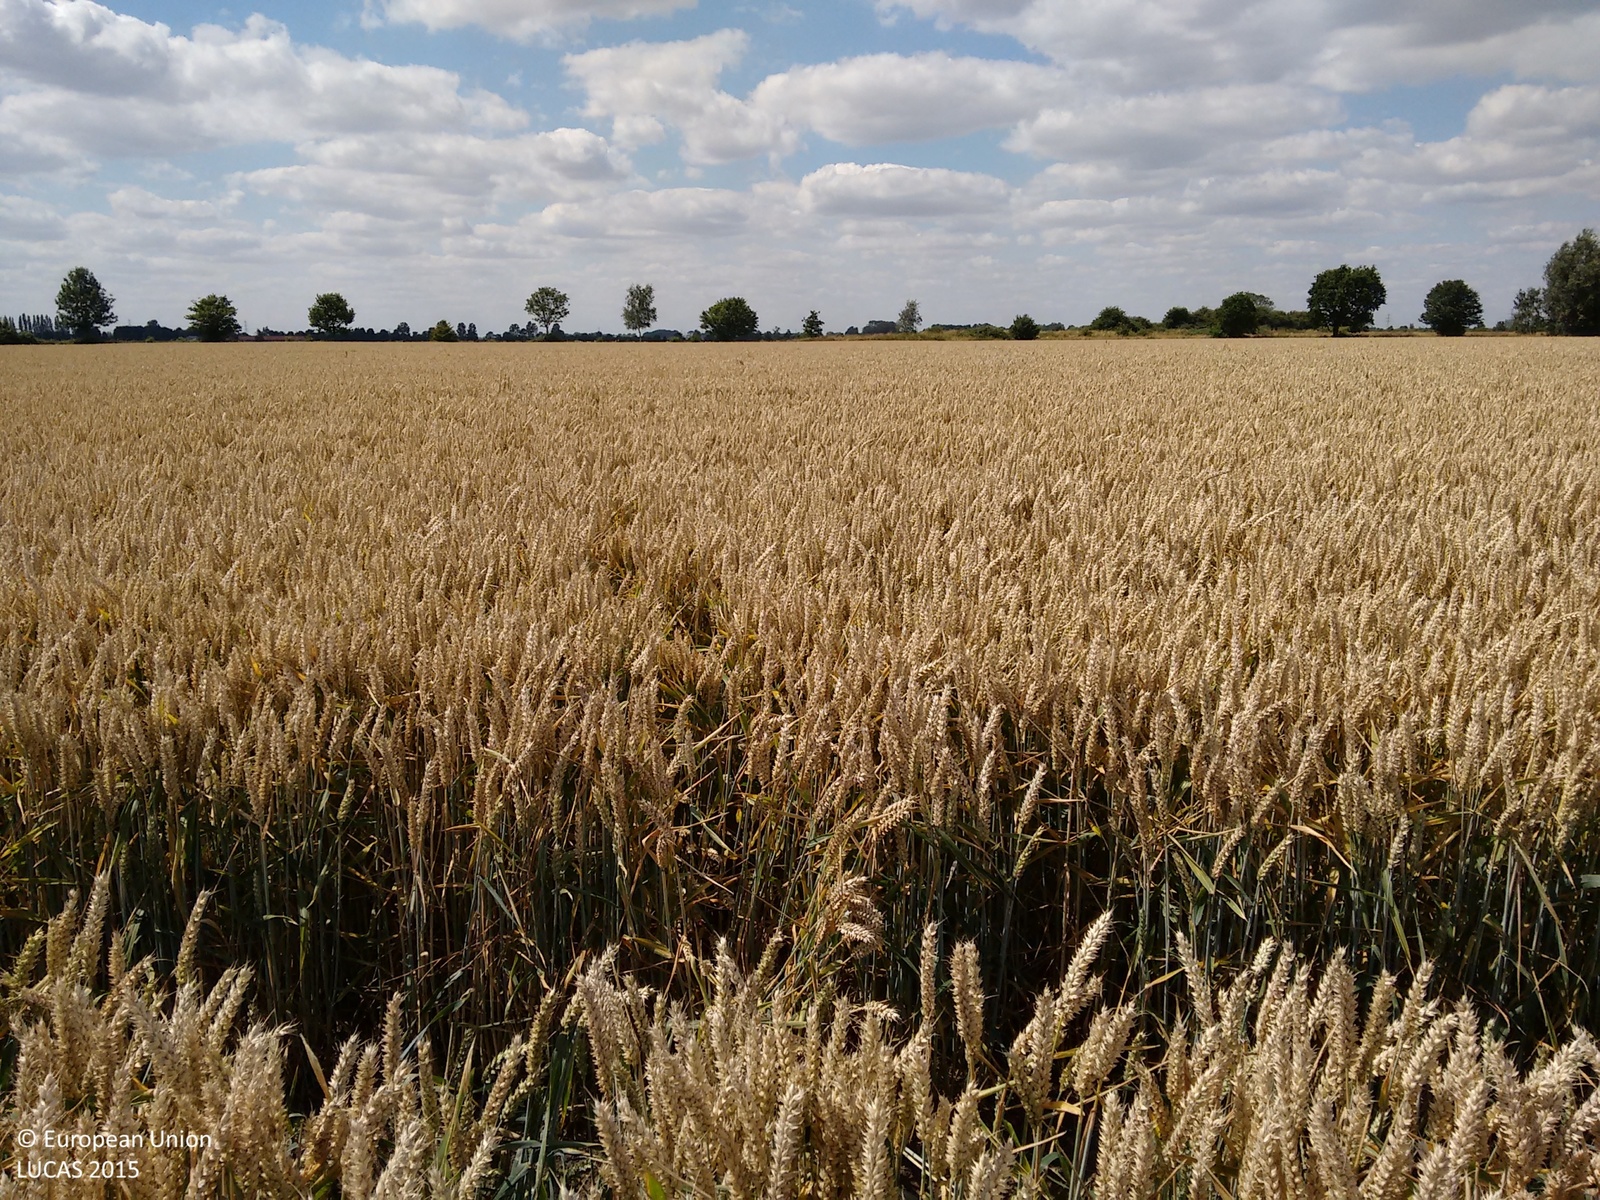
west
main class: Cropland
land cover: Common wheat
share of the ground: > 75 %
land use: Agriculture (excluding fallow land and kitchen gardens)
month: July
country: GB
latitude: 52.7269
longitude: 0.3614
